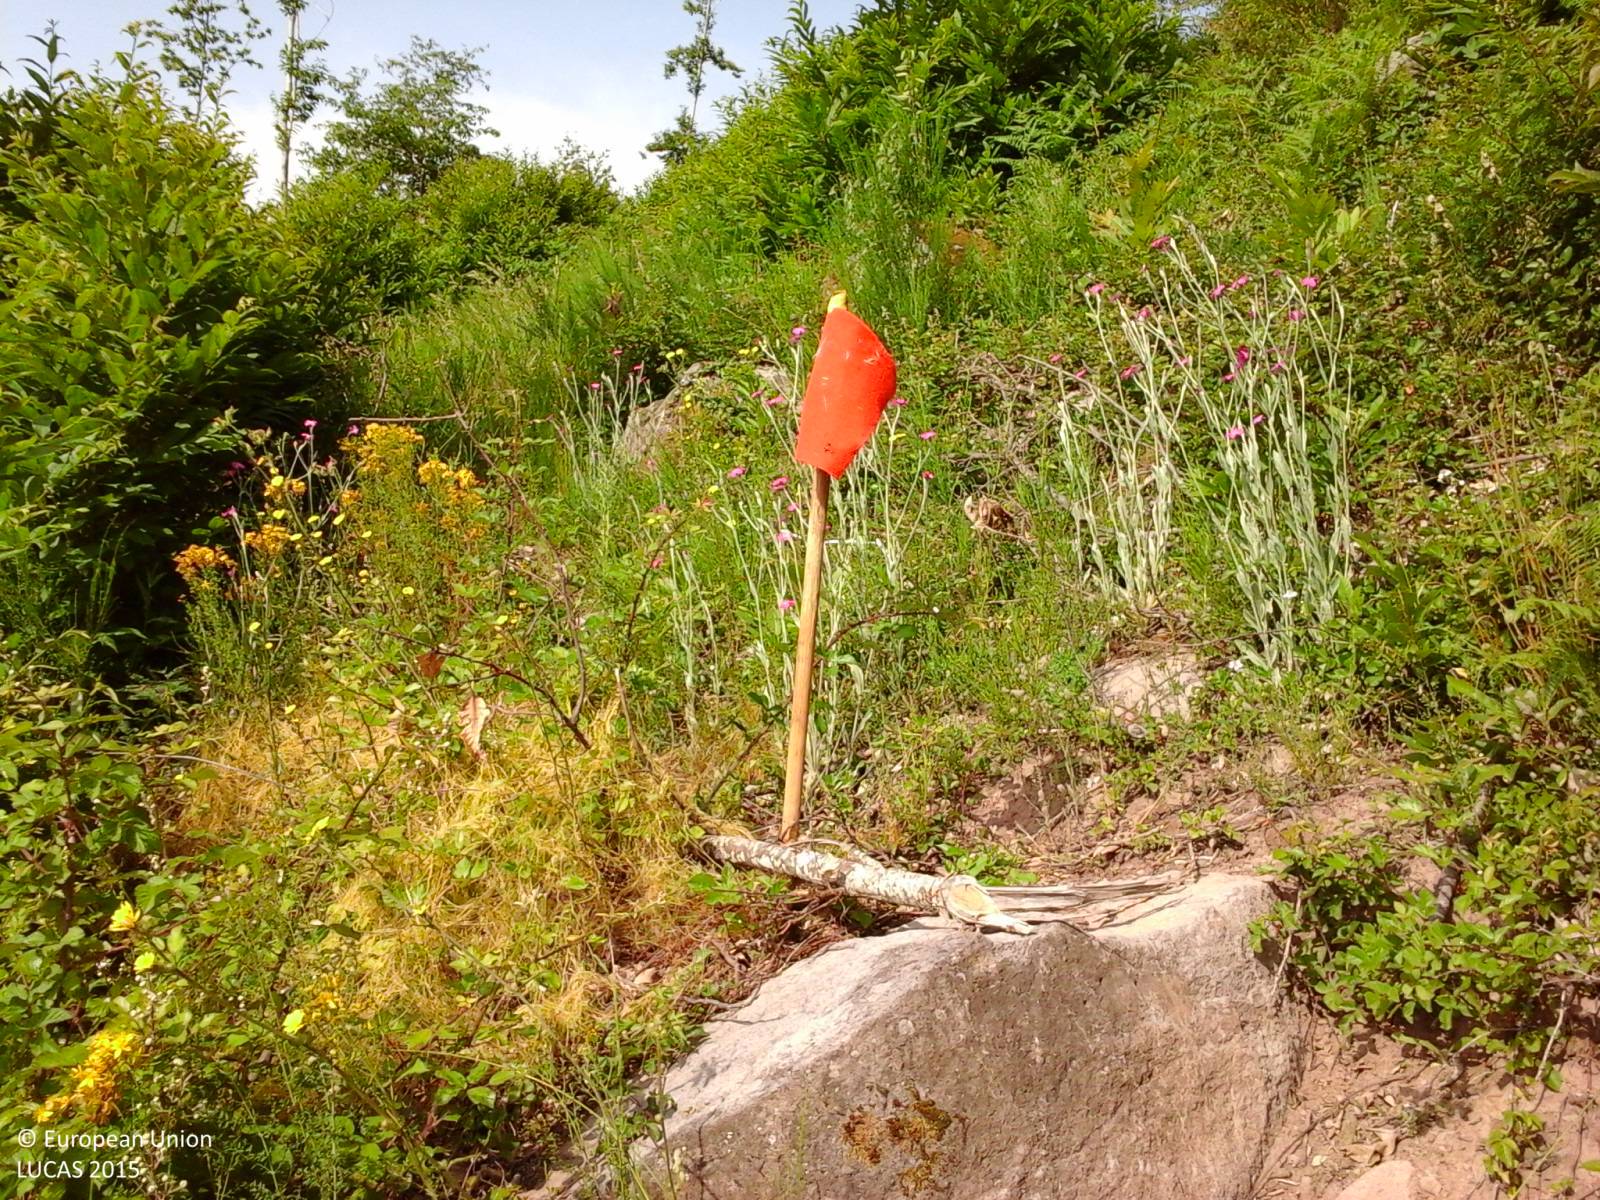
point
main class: Woodland
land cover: Broadleaved woodland
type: thermophilous deciduous forest
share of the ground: > 75 %
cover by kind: broadleaved forest trees 95 %, coniferous forest trees 5 %
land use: Forestry
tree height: > 5 m
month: June
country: IT
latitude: 42.3949
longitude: 12.2156
